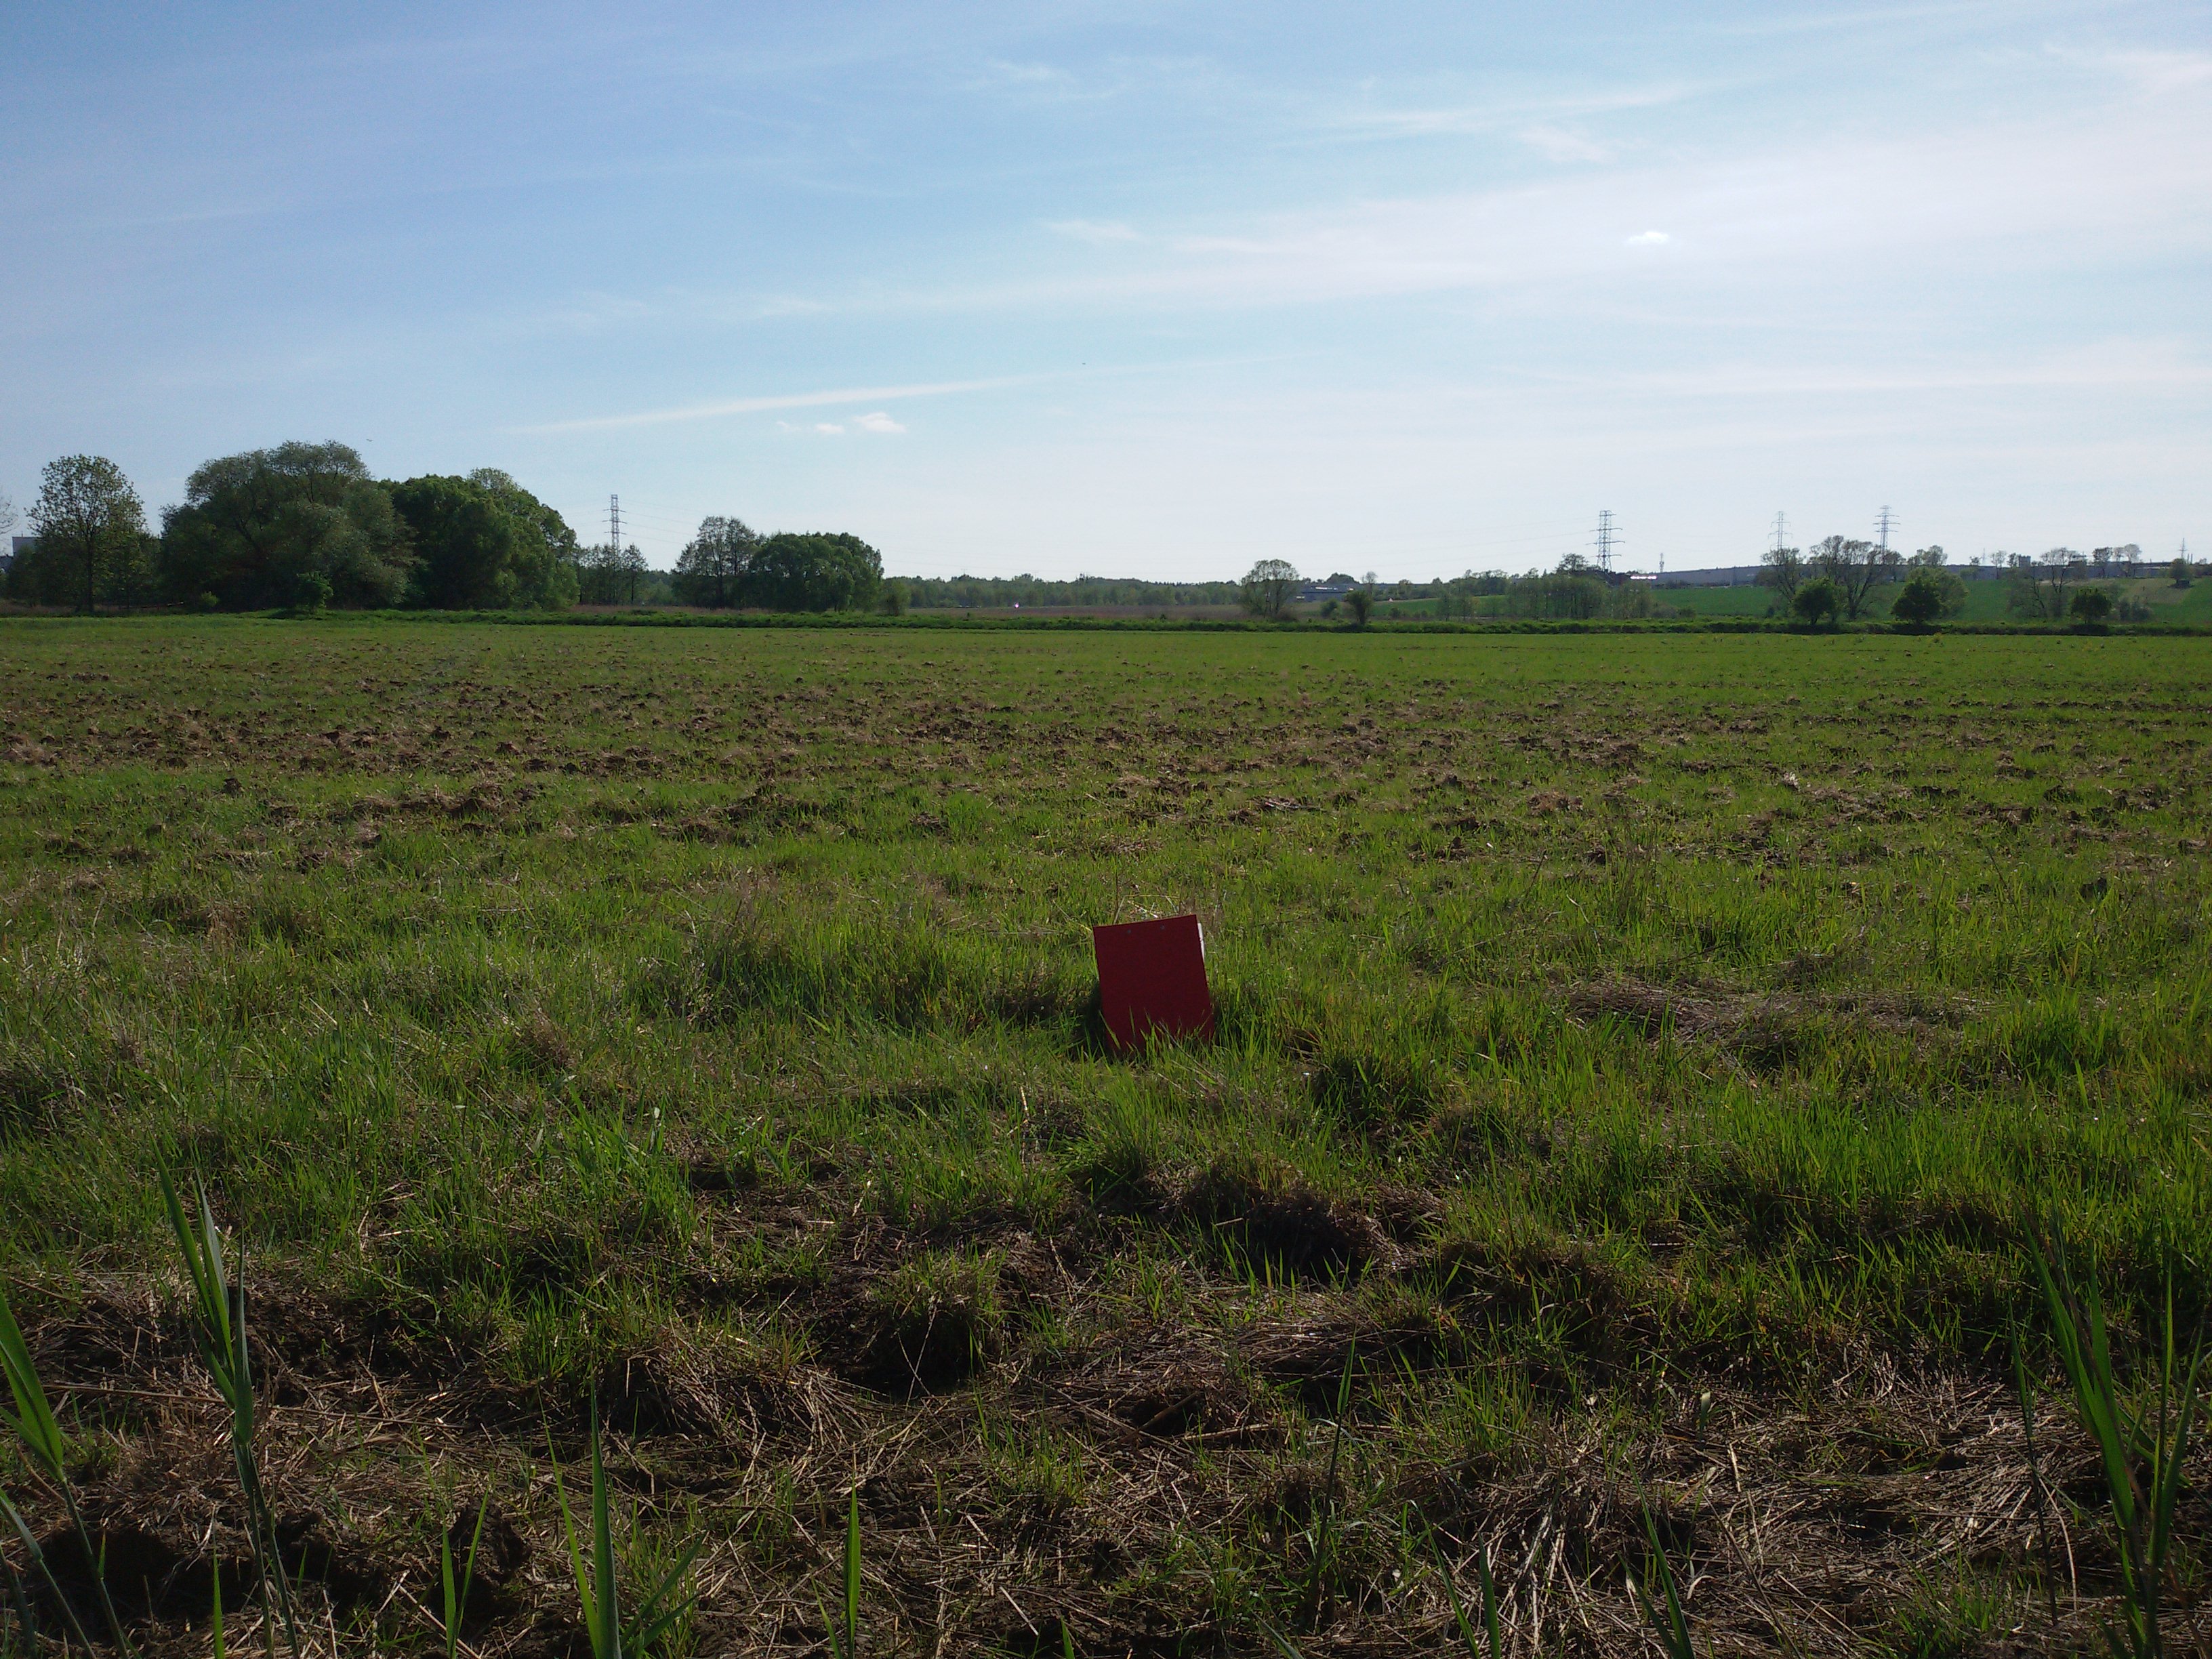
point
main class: Cropland
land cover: Temporary grasslands
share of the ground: > 75 %
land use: Agriculture (excluding fallow land and kitchen gardens)
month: May
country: PL
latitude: 50.3267
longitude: 18.6308
